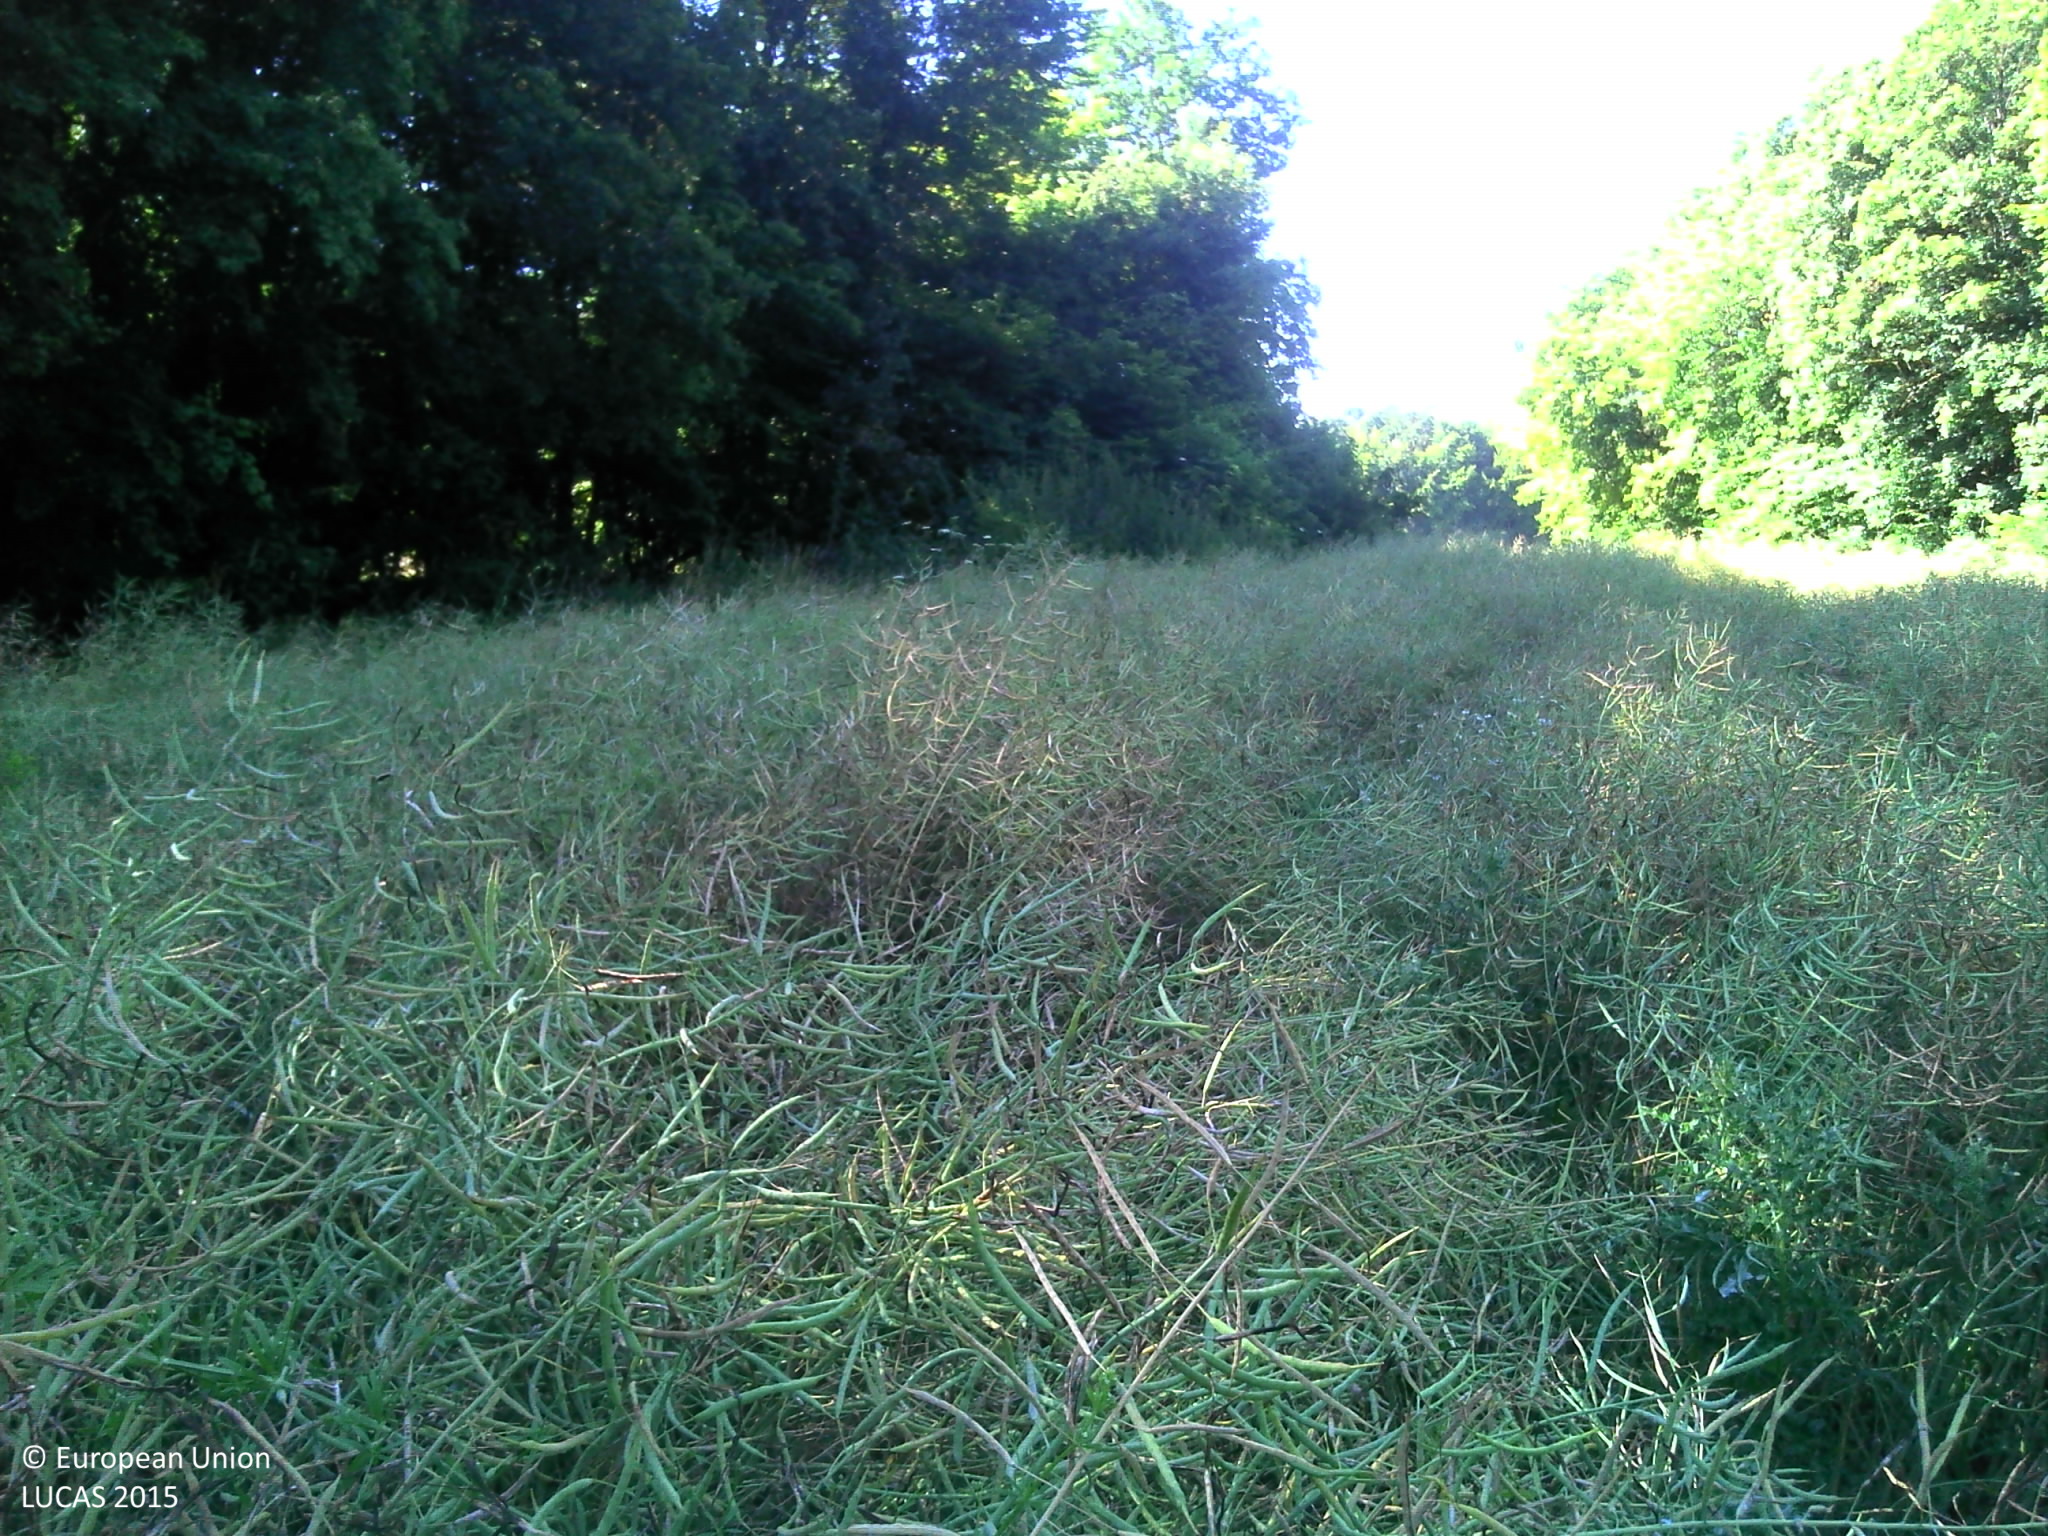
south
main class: Cropland
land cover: Rape and turnip rape
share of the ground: > 75 %
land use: Agriculture (excluding fallow land and kitchen gardens)
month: June
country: FR
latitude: 48.6936
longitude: 5.1484
